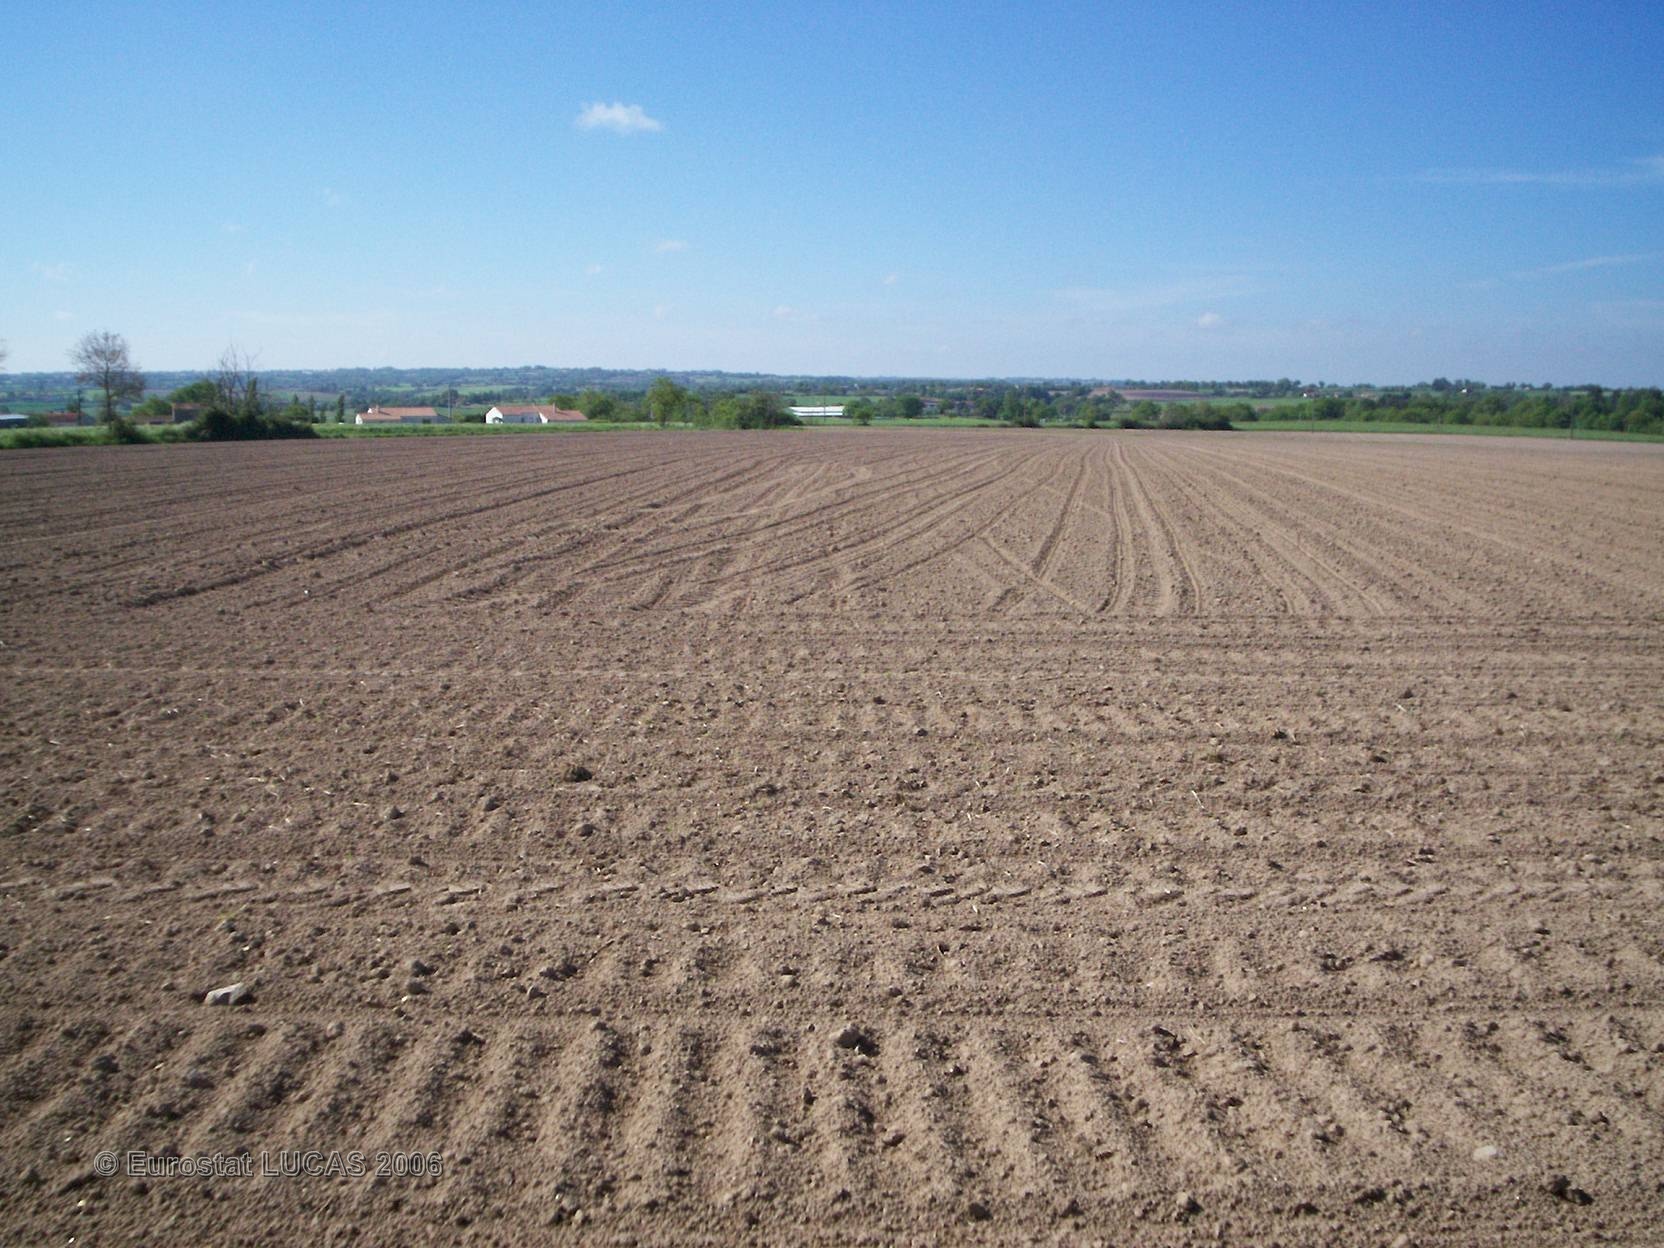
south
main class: Cropland
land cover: Maize
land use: Agriculture (excluding fallow land and kitchen gardens)
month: May
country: FR
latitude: 47.0155
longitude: -1.0190
